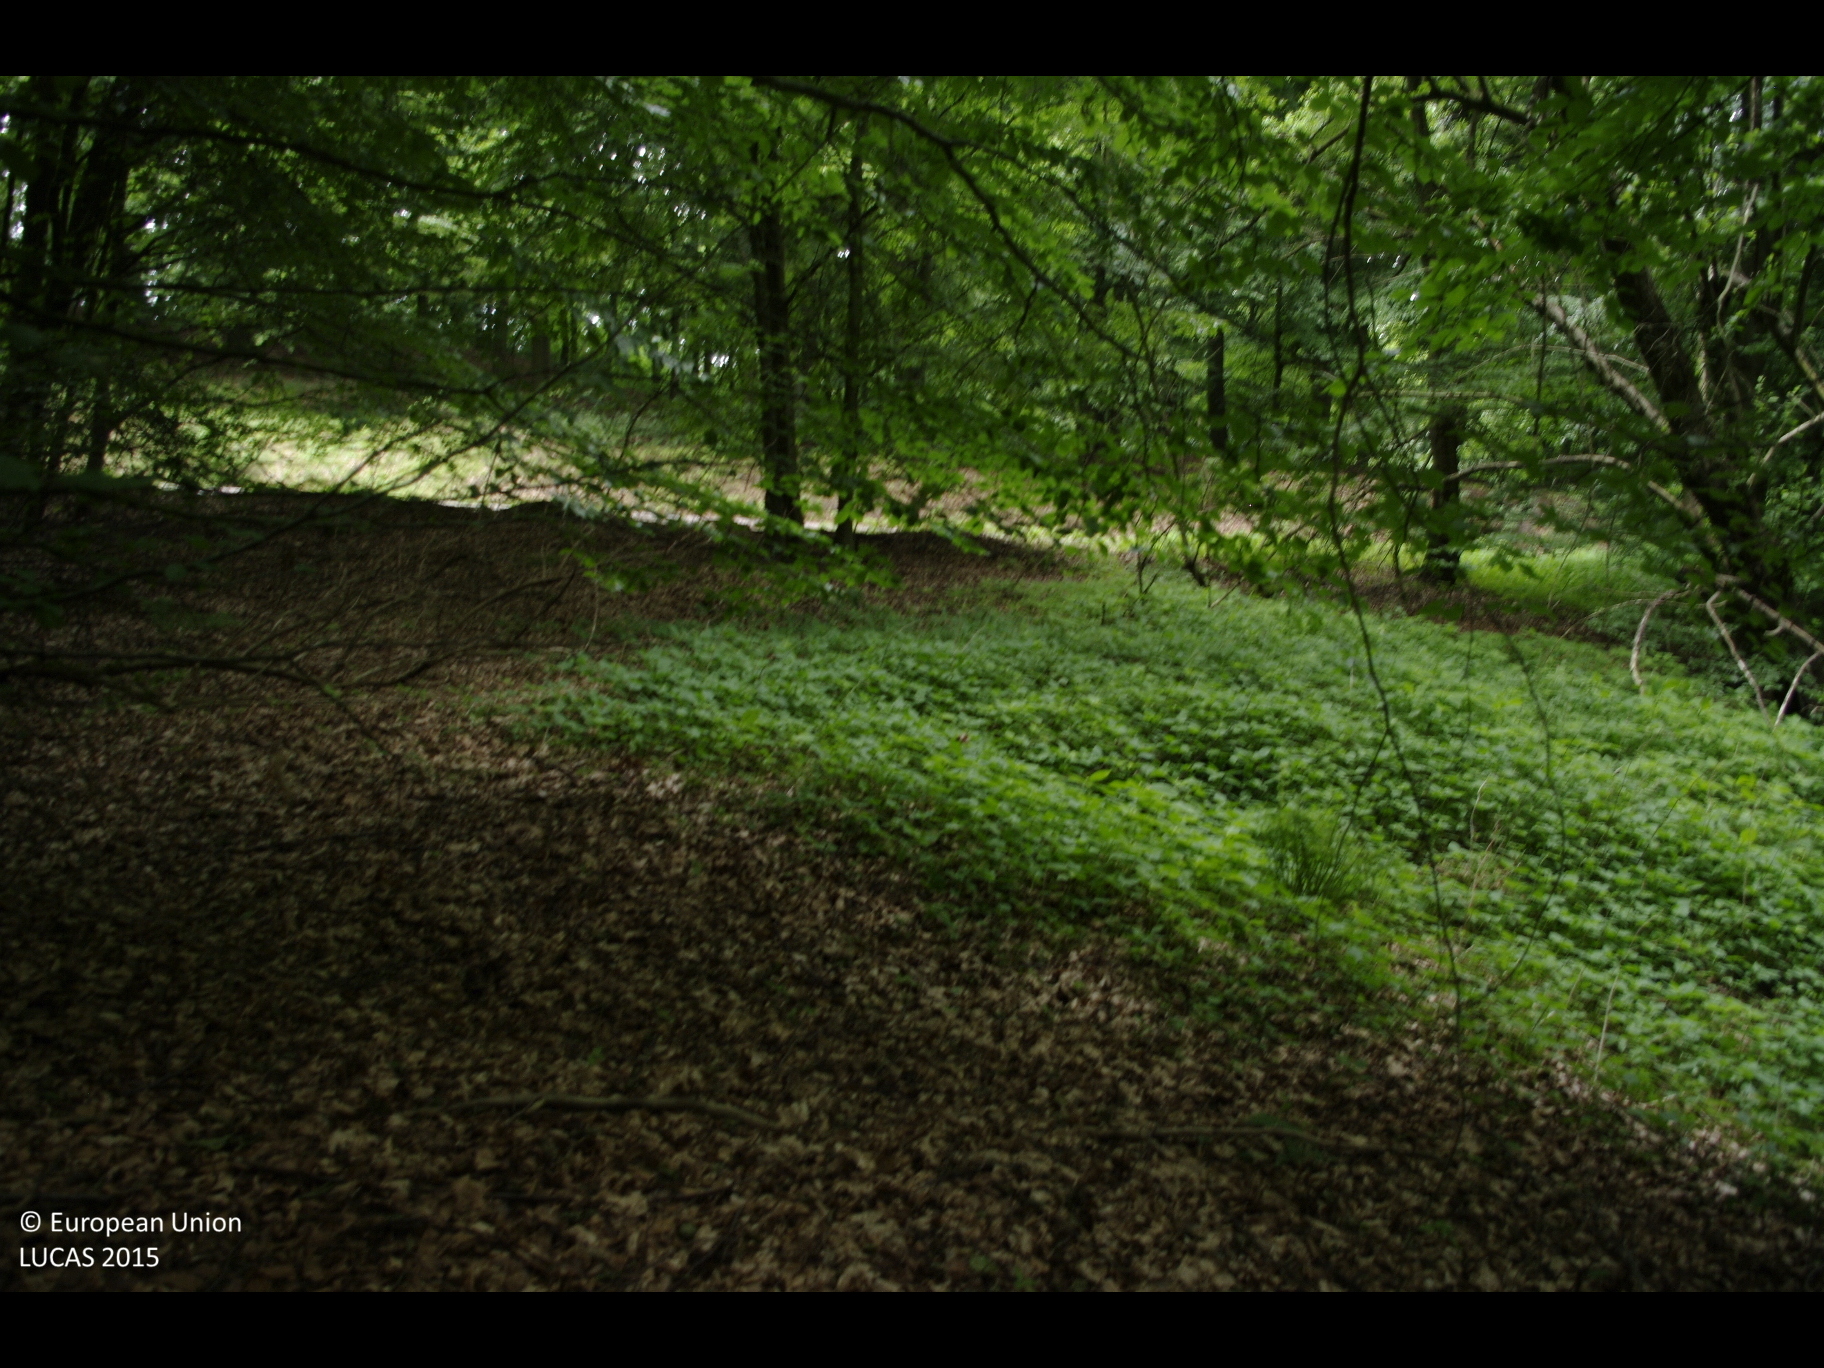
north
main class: Woodland
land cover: Broadleaved woodland
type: mesophytic deciduous forest
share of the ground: > 75 %
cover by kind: broadleaved forest trees 90 %, herbaceous plants 5 %, unconsolidated bare surface 5 %
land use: Forestry
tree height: > 5 m
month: July
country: DE
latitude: 53.4558
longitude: 9.9247
